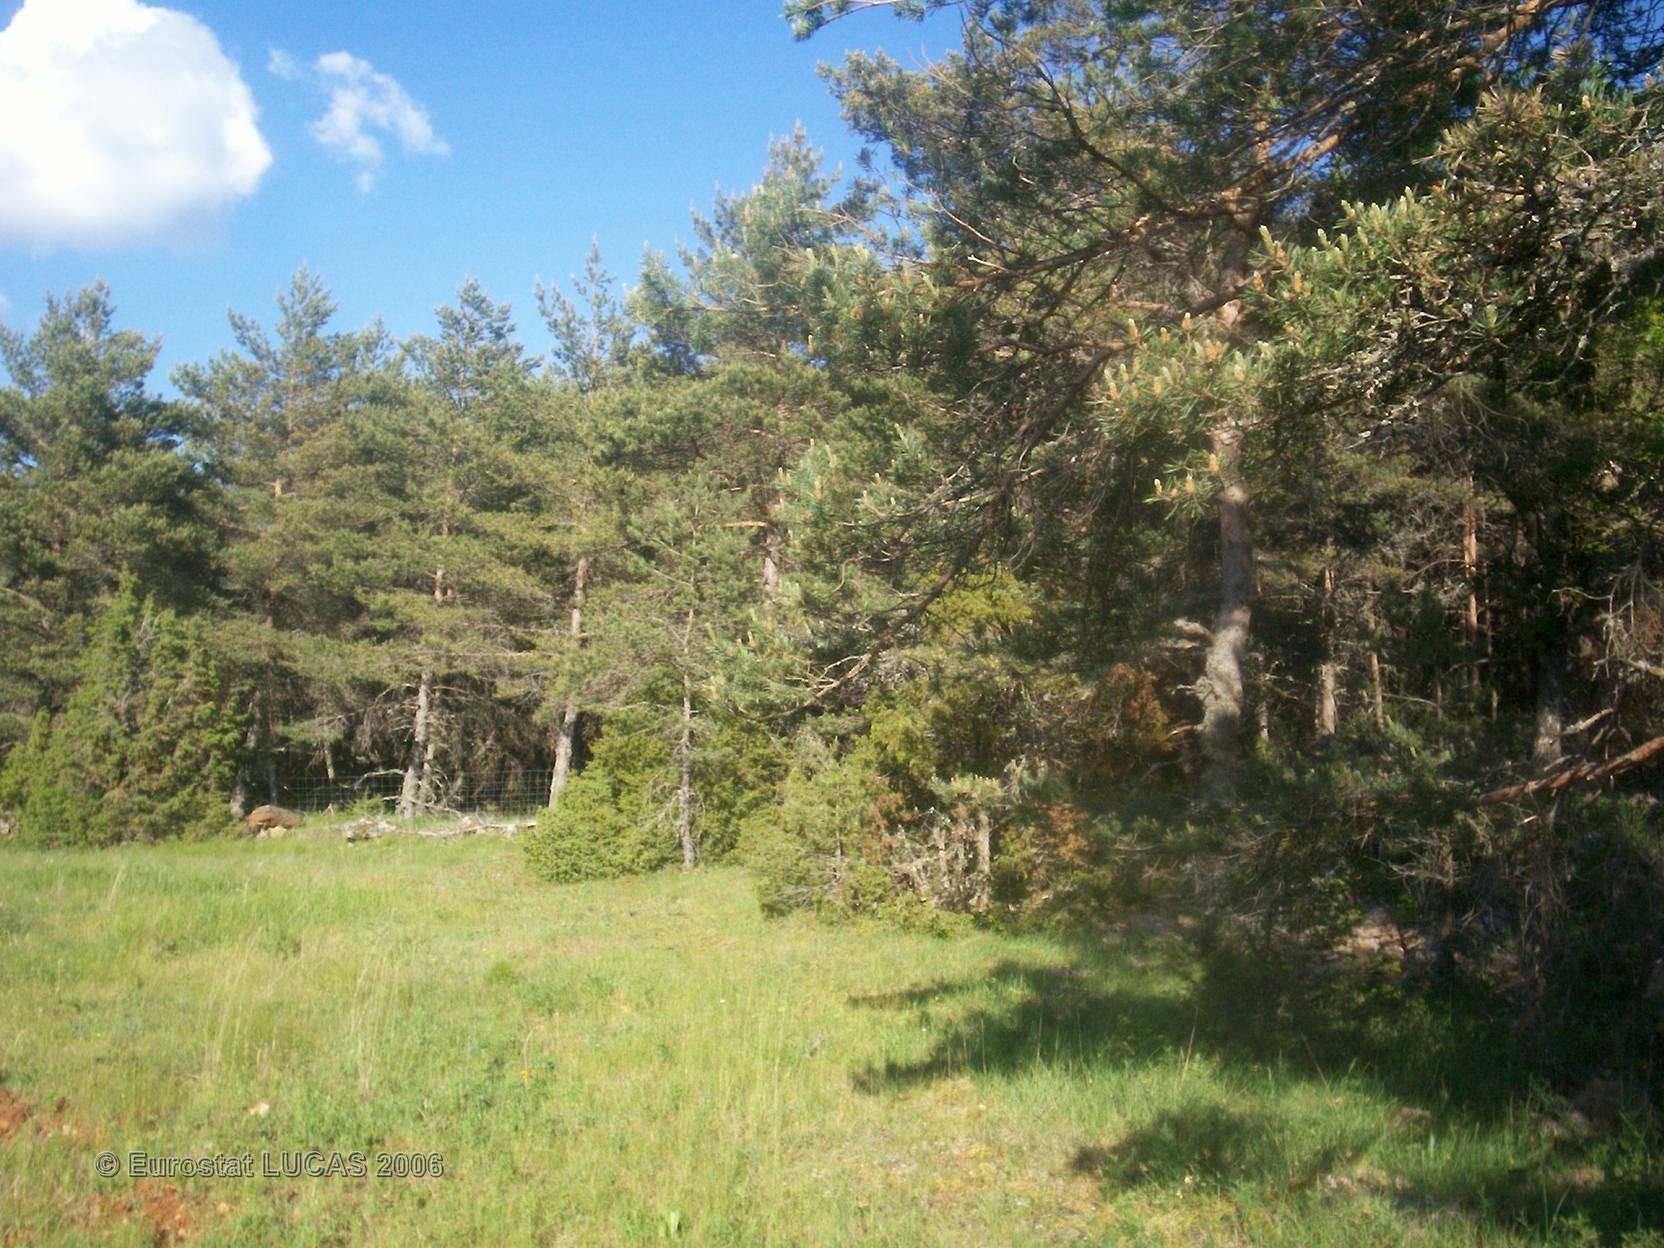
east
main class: Grassland
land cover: Grassland without tree/shrub cover
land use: Agriculture (excluding fallow land and kitchen gardens)
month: June
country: FR
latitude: 44.2868
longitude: 3.4269
